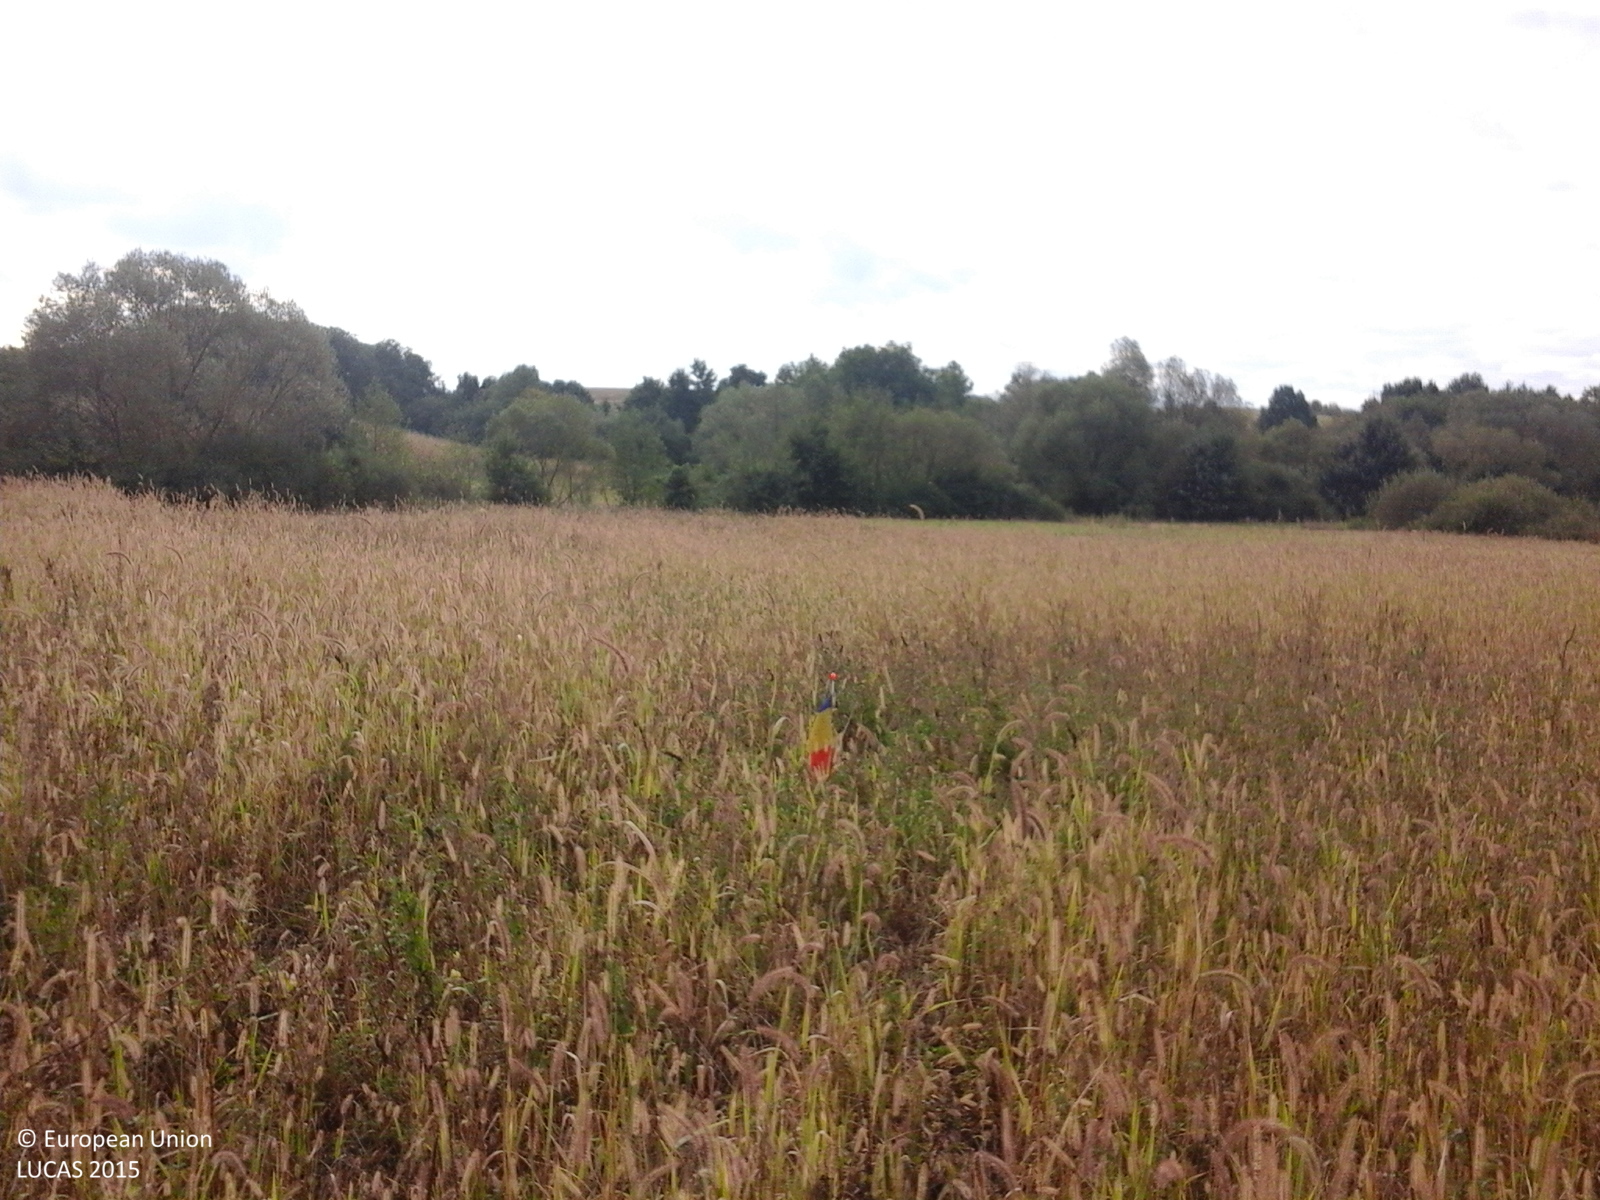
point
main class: Grassland
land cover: Grassland without tree/shrub cover
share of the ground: > 75 %
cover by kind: herbaceous plants 100 %
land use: Agriculture (excluding fallow land and kitchen gardens)
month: September
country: RO
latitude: 47.5934
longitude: 23.4656
